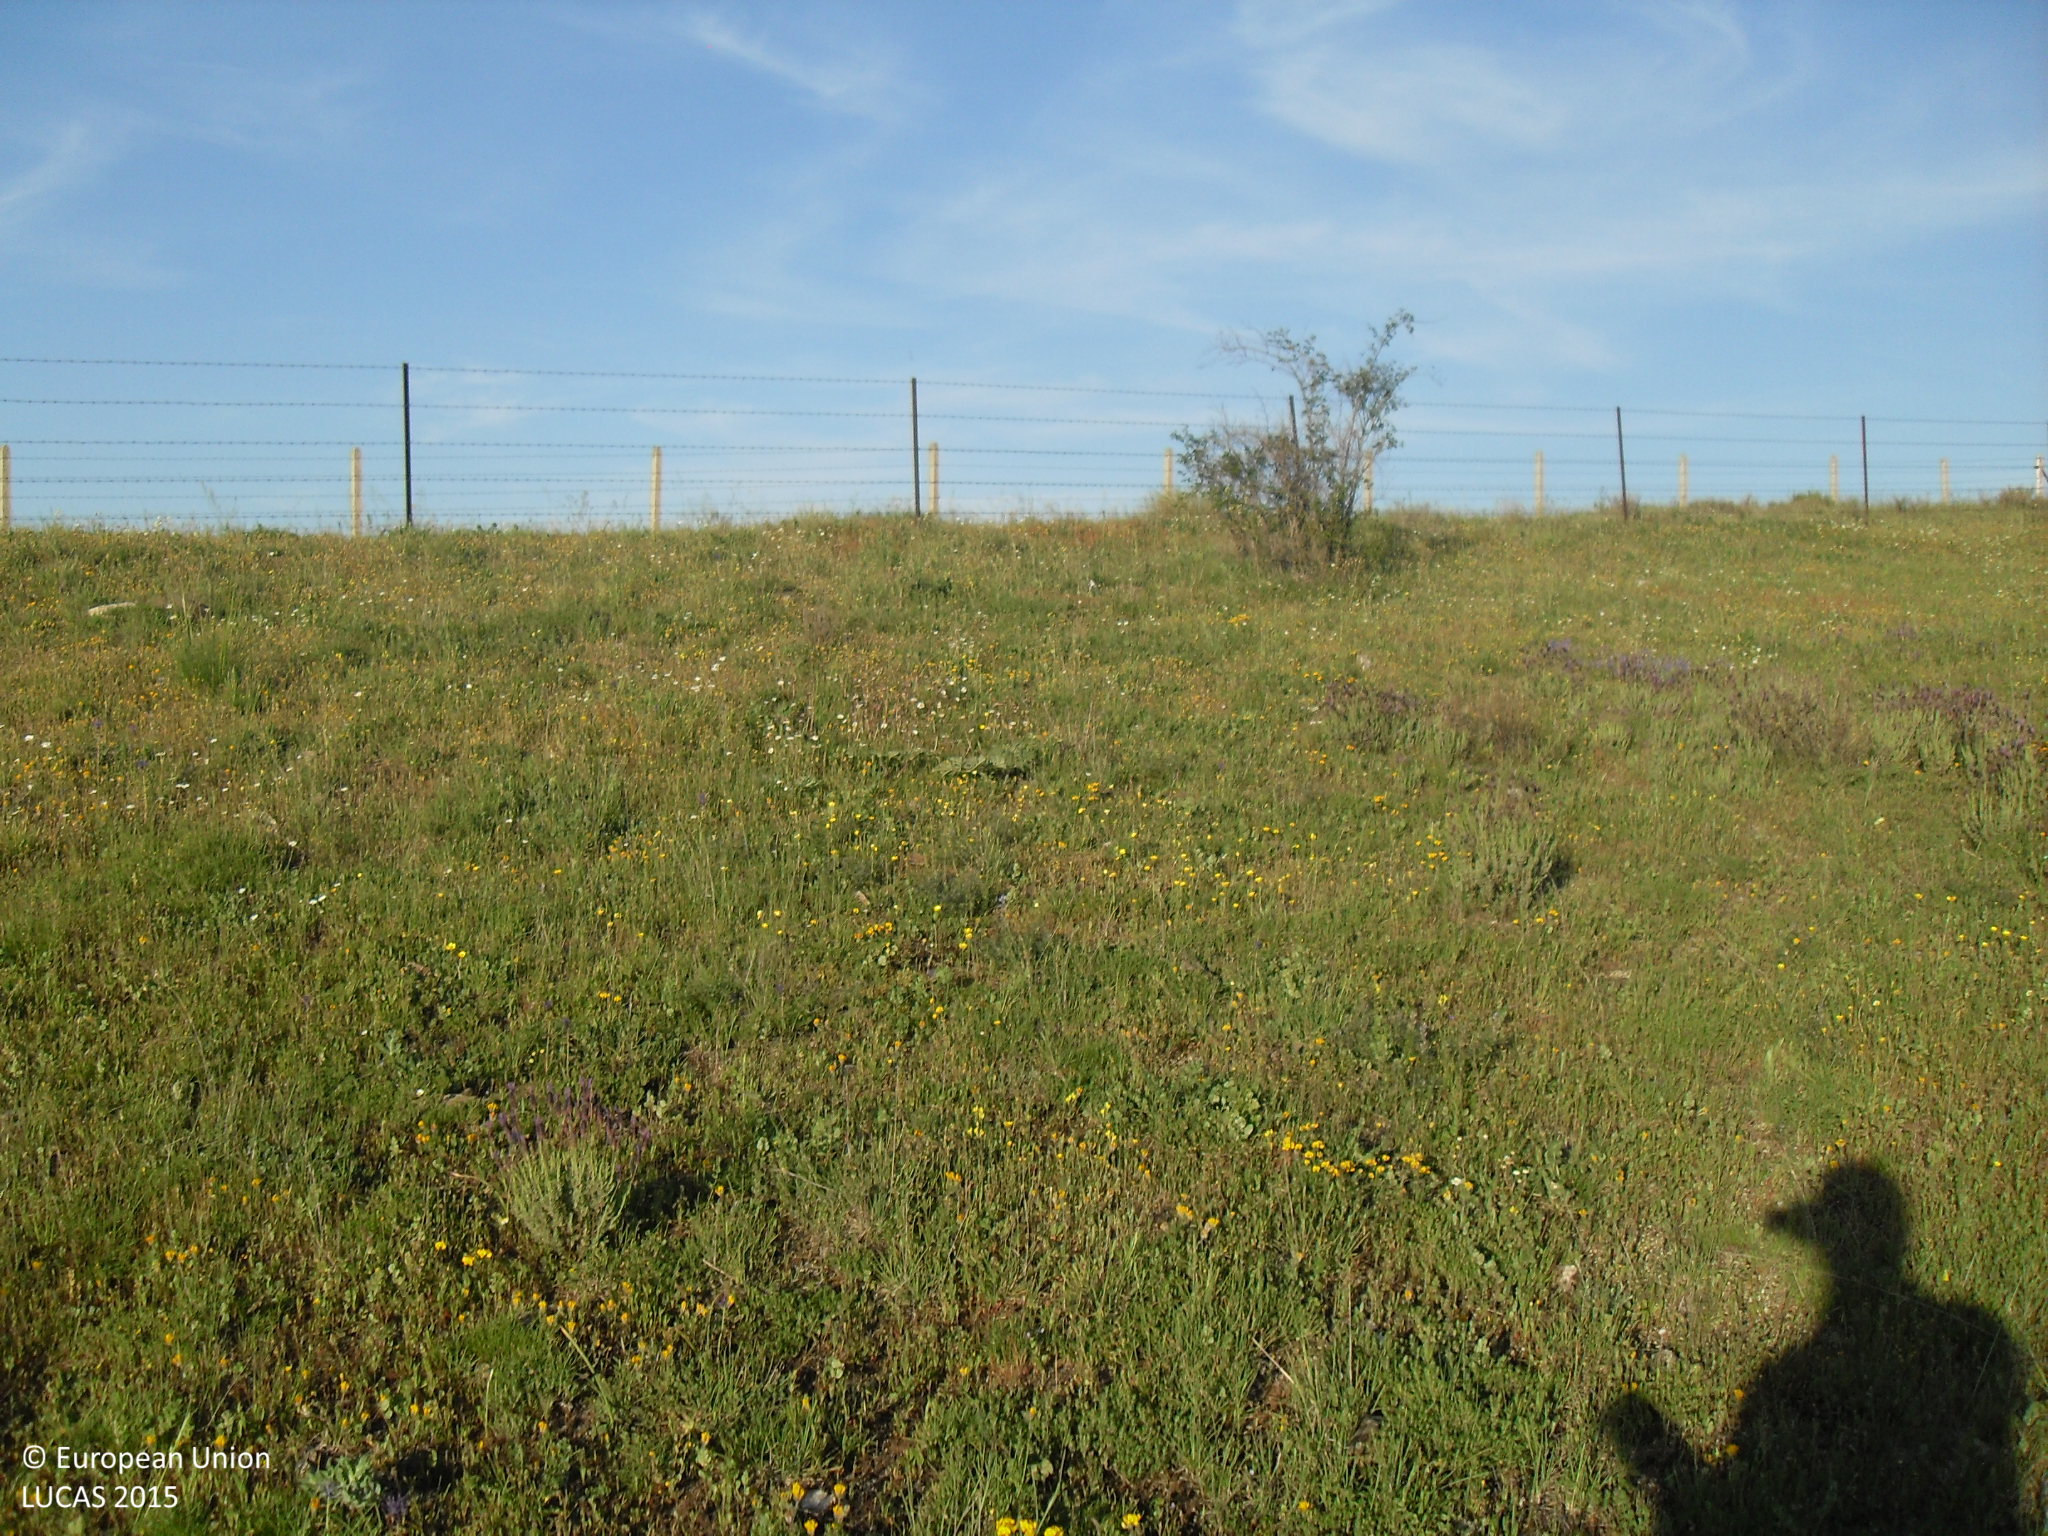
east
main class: Grassland
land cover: Grassland with sparse tree/shrub cover
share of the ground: > 75 %
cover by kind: herbaceous plants 95 %, broadleaved forest trees 5 %
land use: Agriculture (excluding fallow land and kitchen gardens)
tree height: < 5 m
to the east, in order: Grassland with sparse tree/shrub cover; Fences; Tracks; Fences; Grassland with sparse tree/shrub cover; Grassland without tree/shrub cover
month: May
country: ES
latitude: 40.6884
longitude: -5.1025
